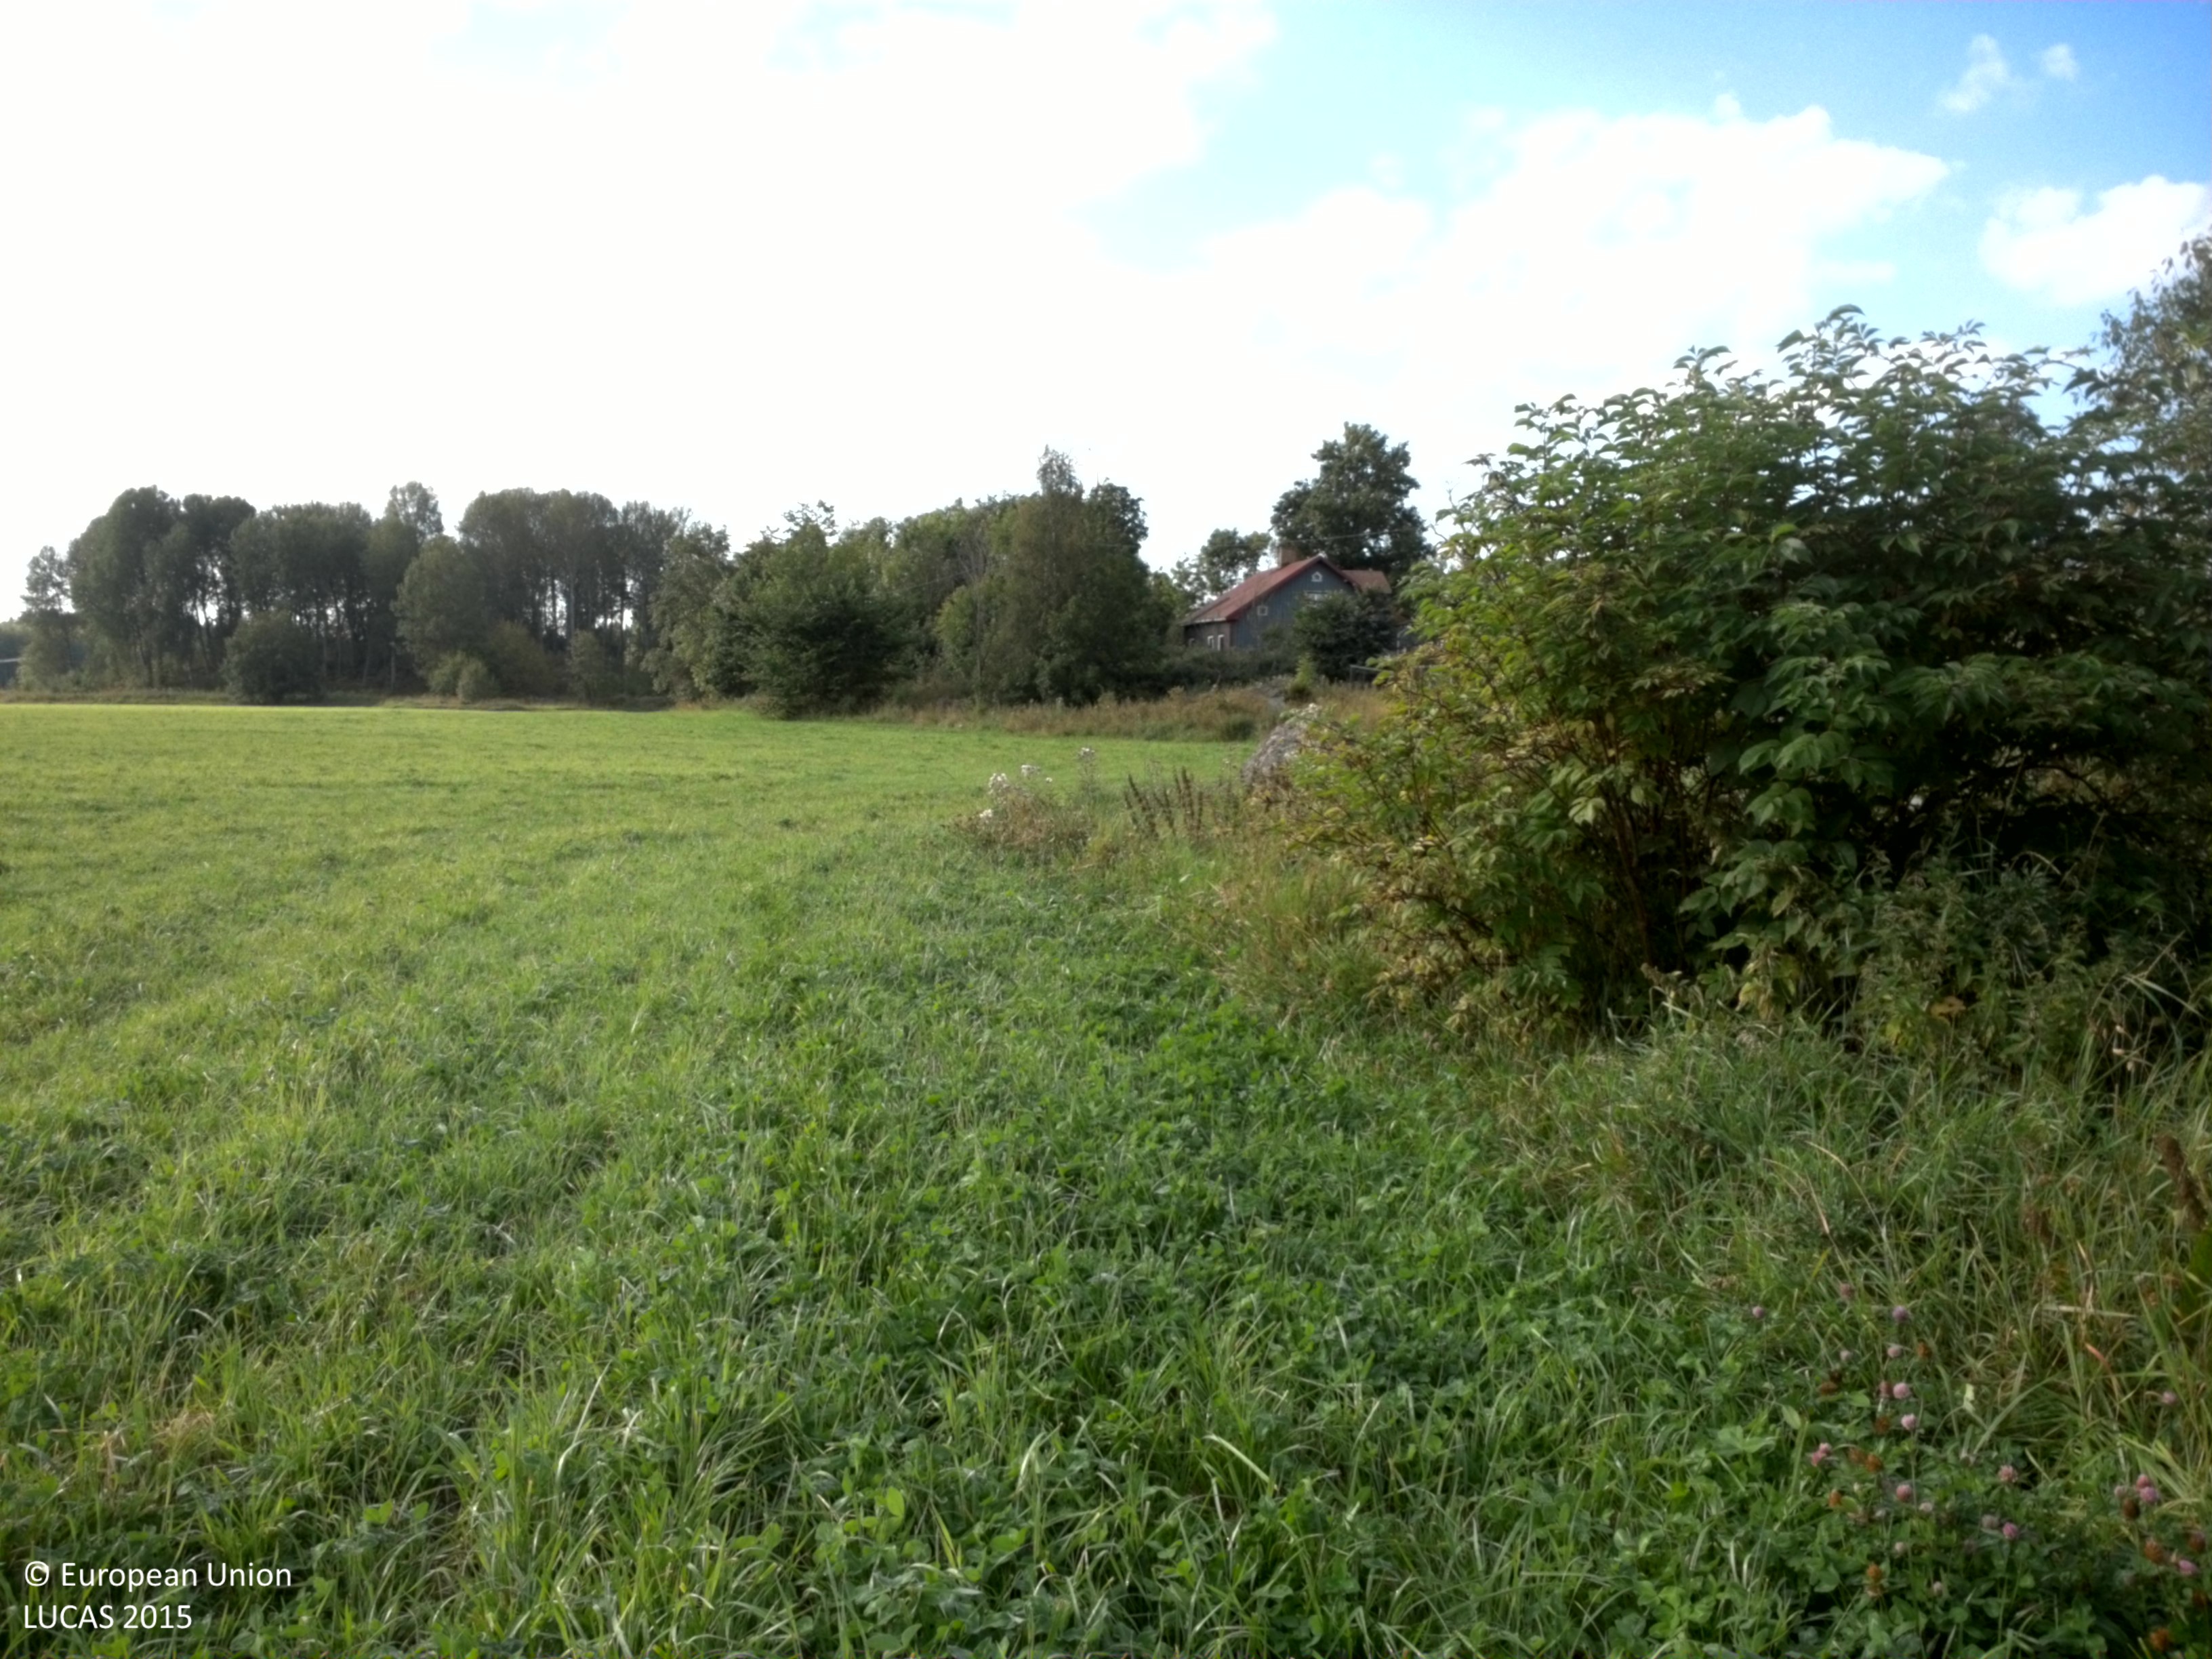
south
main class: Cropland
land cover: Other leguminous and mixtures for fodder
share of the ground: 50 - 75 %
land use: Agriculture (excluding fallow land and kitchen gardens)
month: August
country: SE
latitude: 59.9952
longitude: 17.9008
